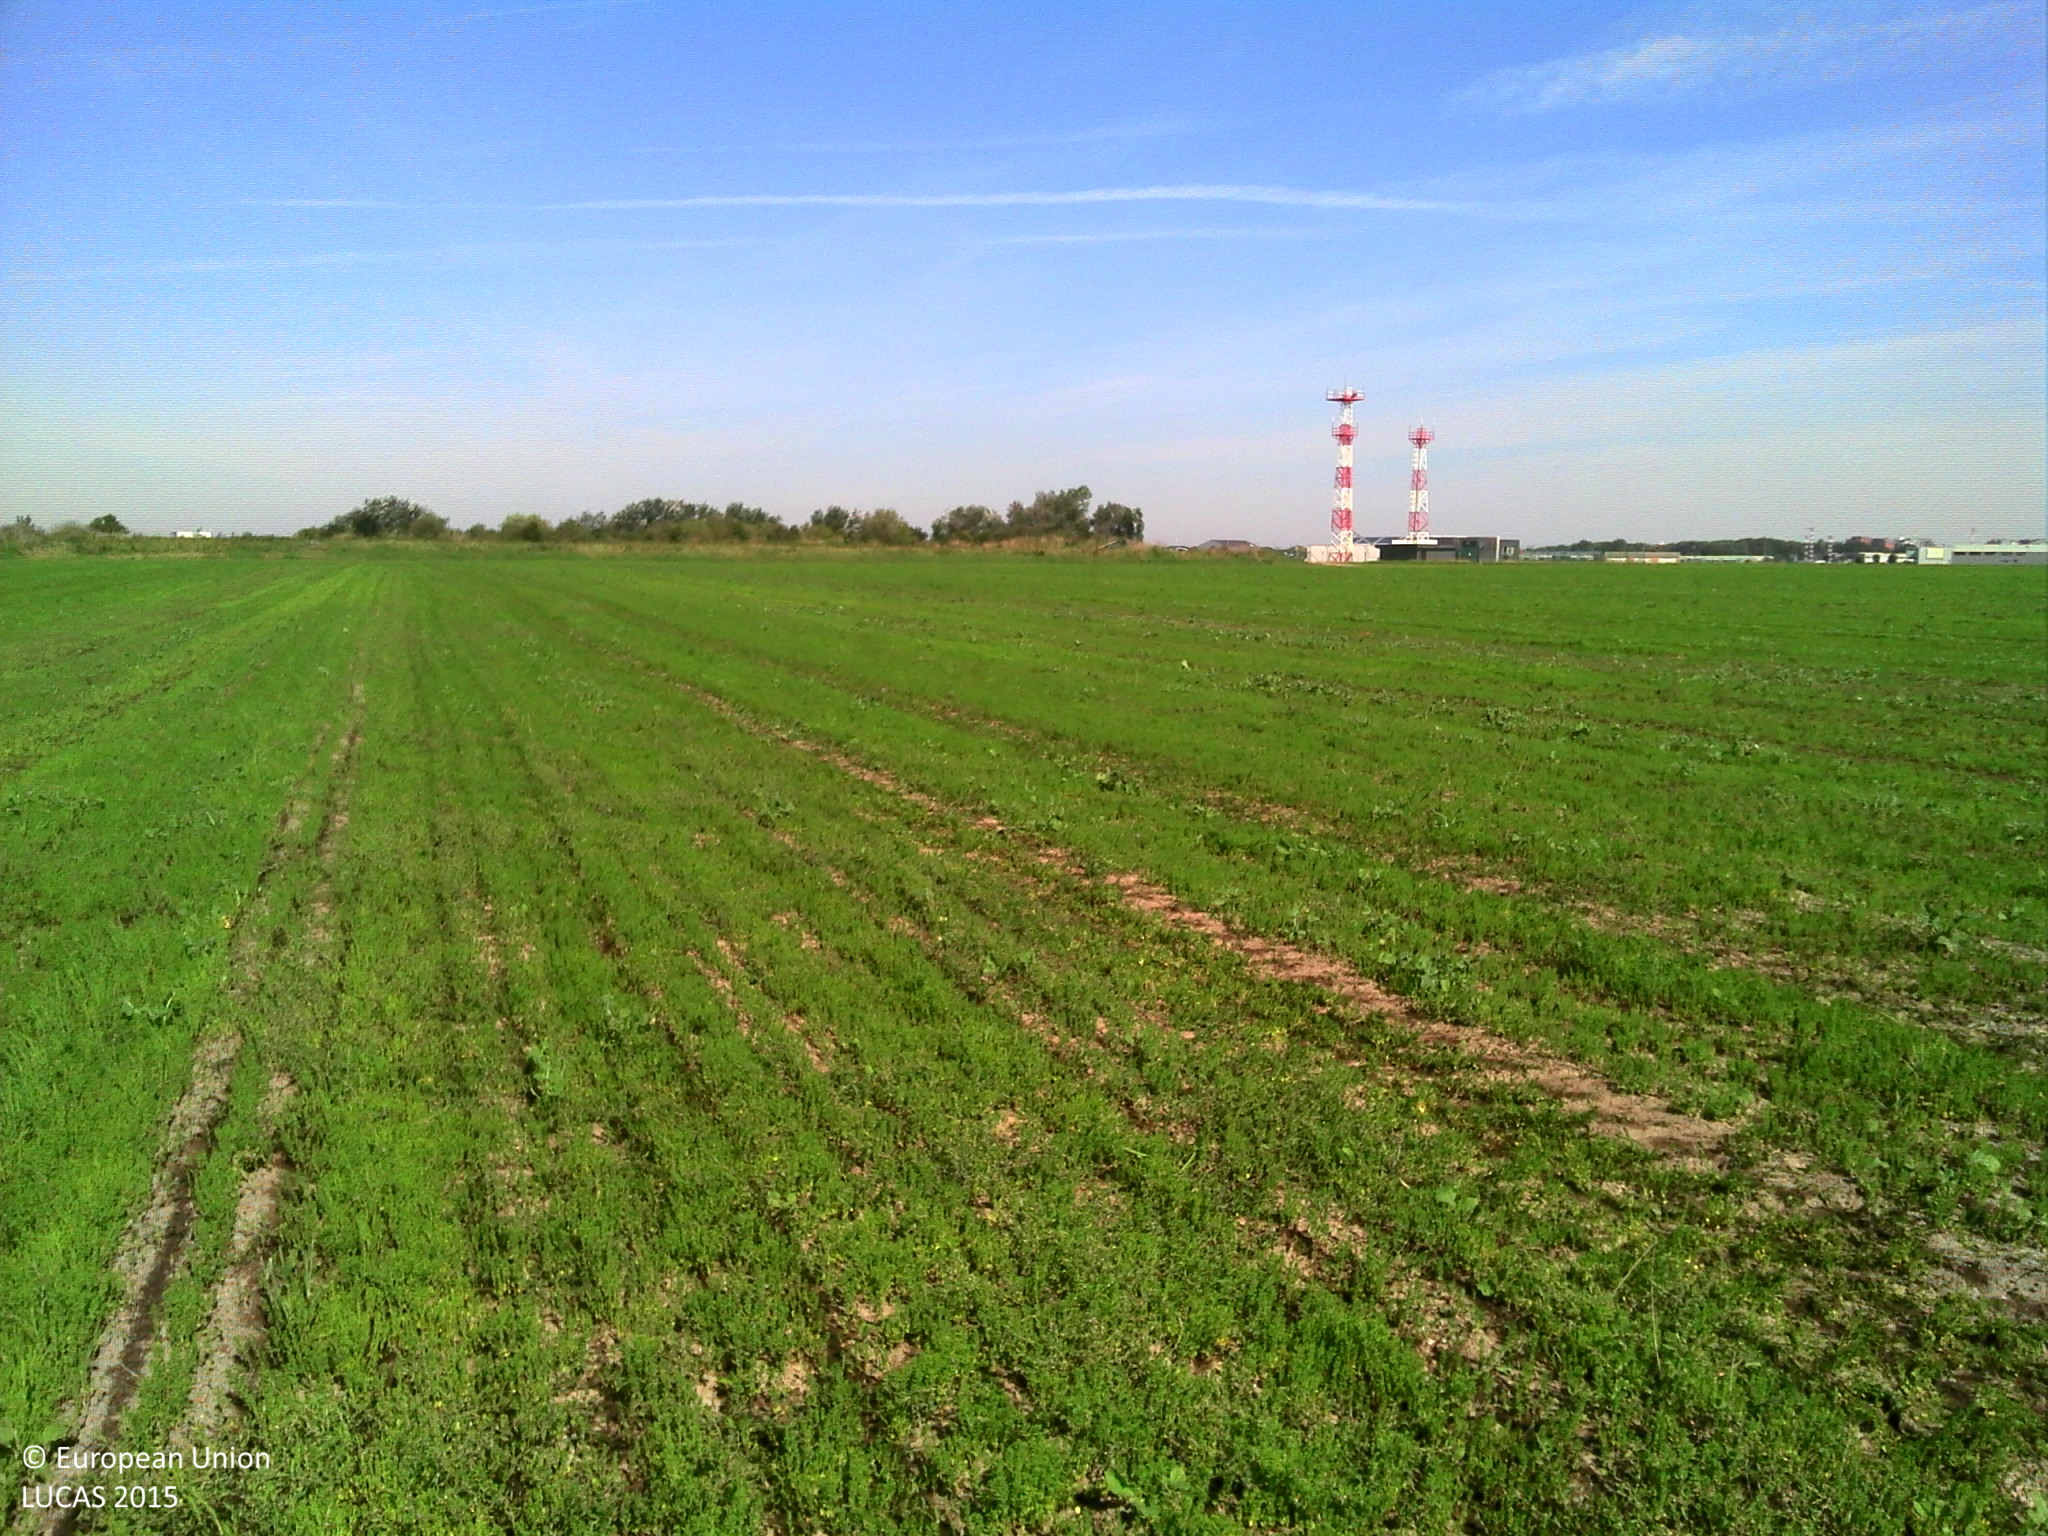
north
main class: Cropland
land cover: Other fibre and oleaginous crops
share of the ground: 50 - 75 %
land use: Agriculture (excluding fallow land and kitchen gardens)
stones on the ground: < 10 %
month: September
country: BE
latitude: 51.1872
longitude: 2.8497
